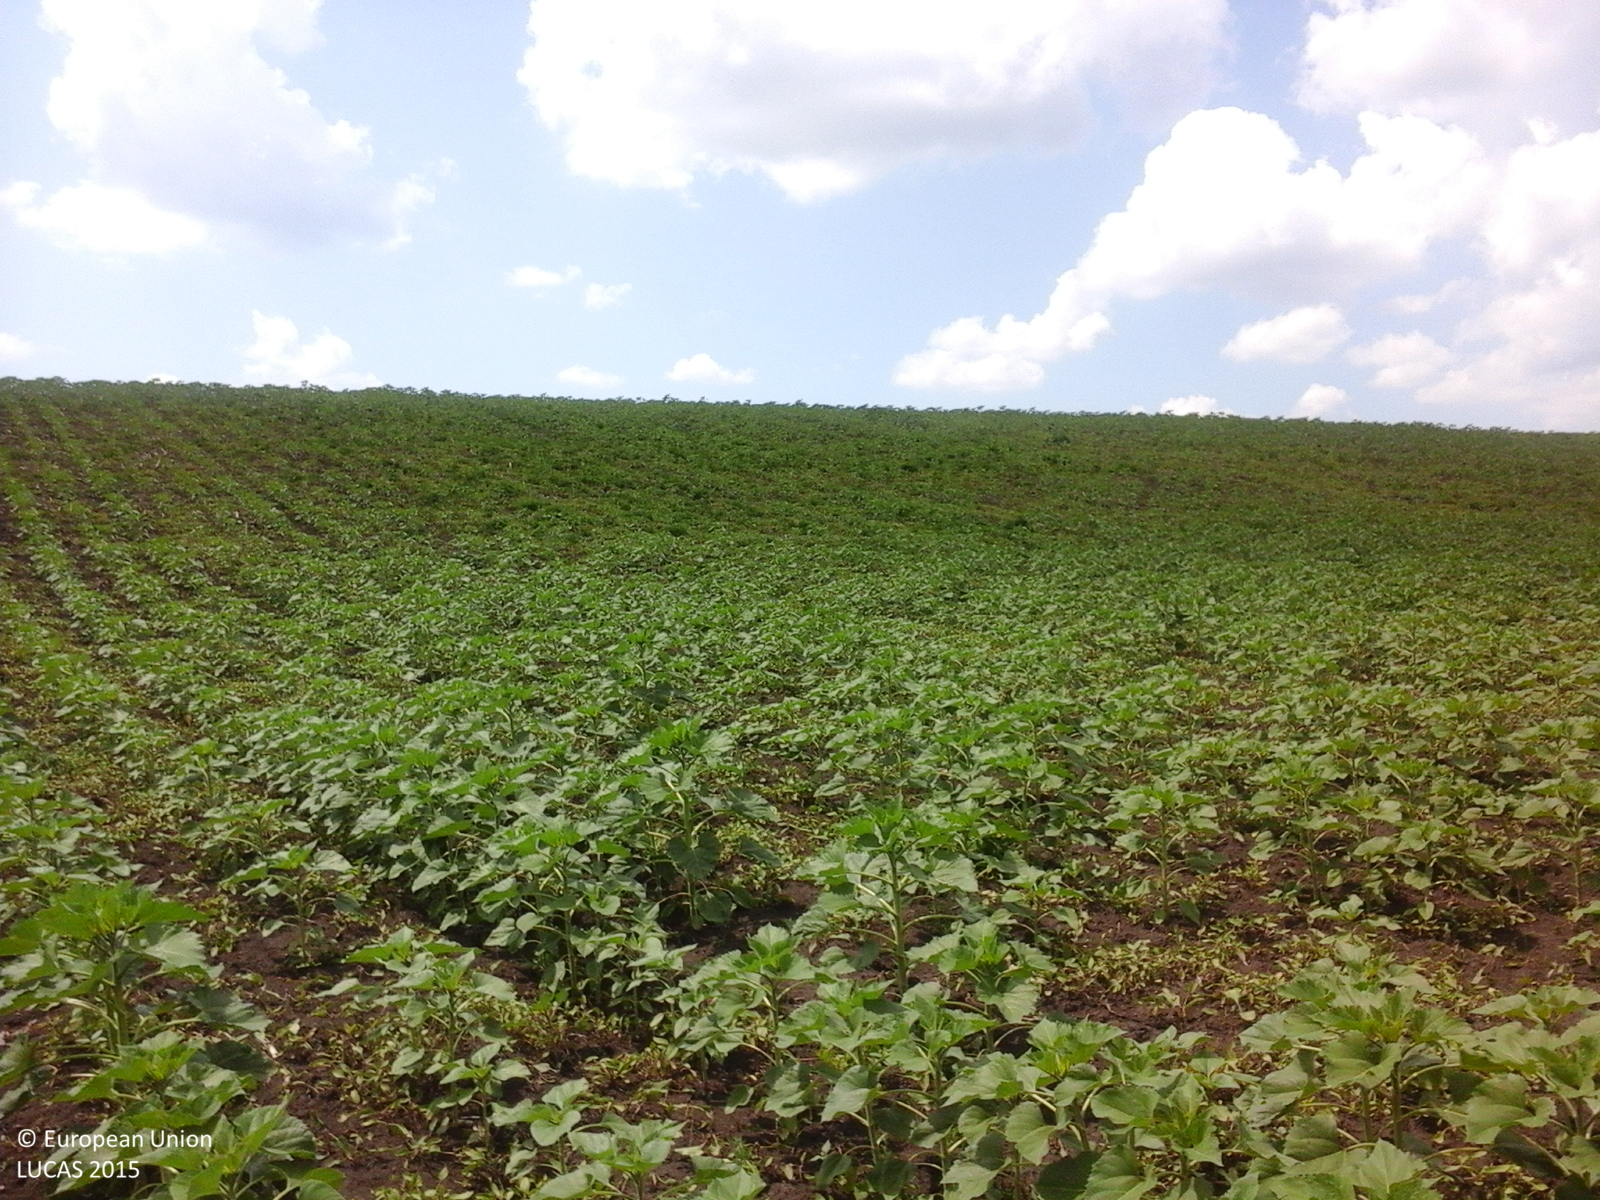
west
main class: Cropland
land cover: Sunflower
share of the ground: 25 - 50 %
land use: Agriculture (excluding fallow land and kitchen gardens)
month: June
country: RO
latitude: 48.0200
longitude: 26.7103
